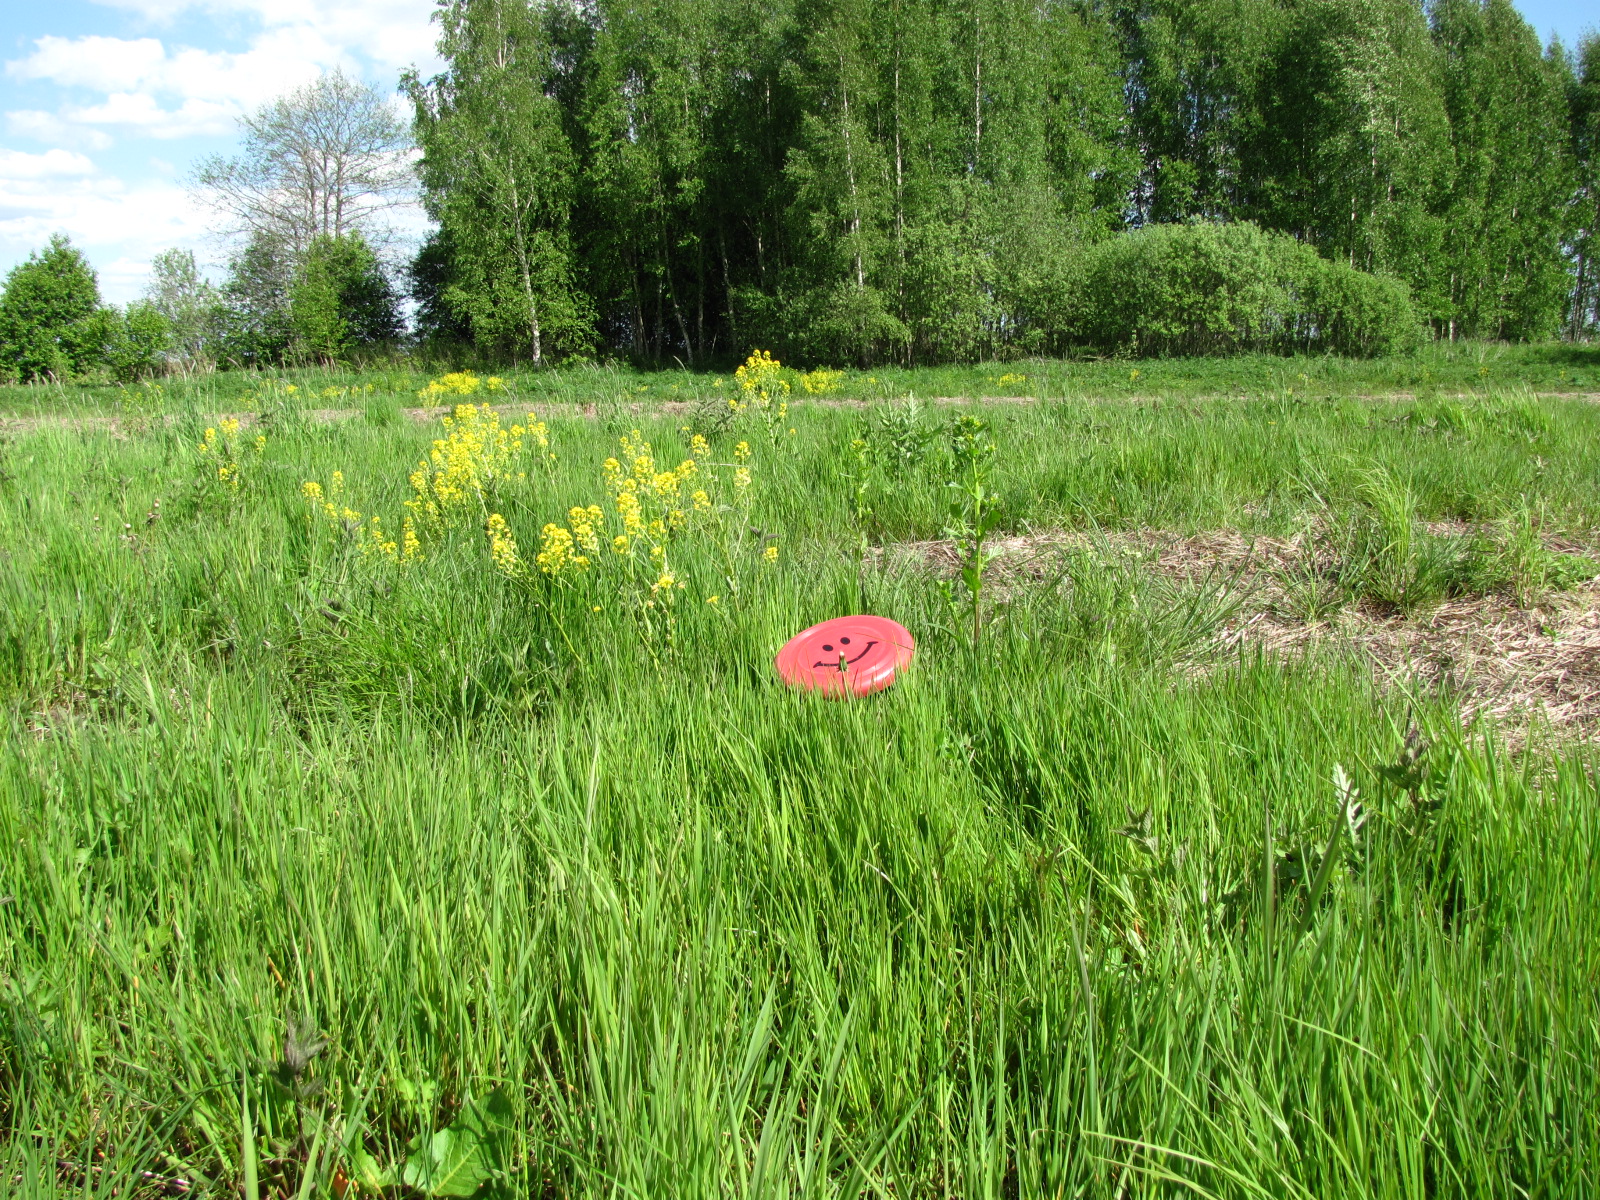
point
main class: Grassland
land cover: Grassland without tree/shrub cover
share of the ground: > 75 %
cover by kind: herbaceous plants 95 %, unconsolidated bare surface 5 %
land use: Agriculture (excluding fallow land and kitchen gardens)
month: May
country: LV
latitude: 56.6373
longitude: 24.0252
